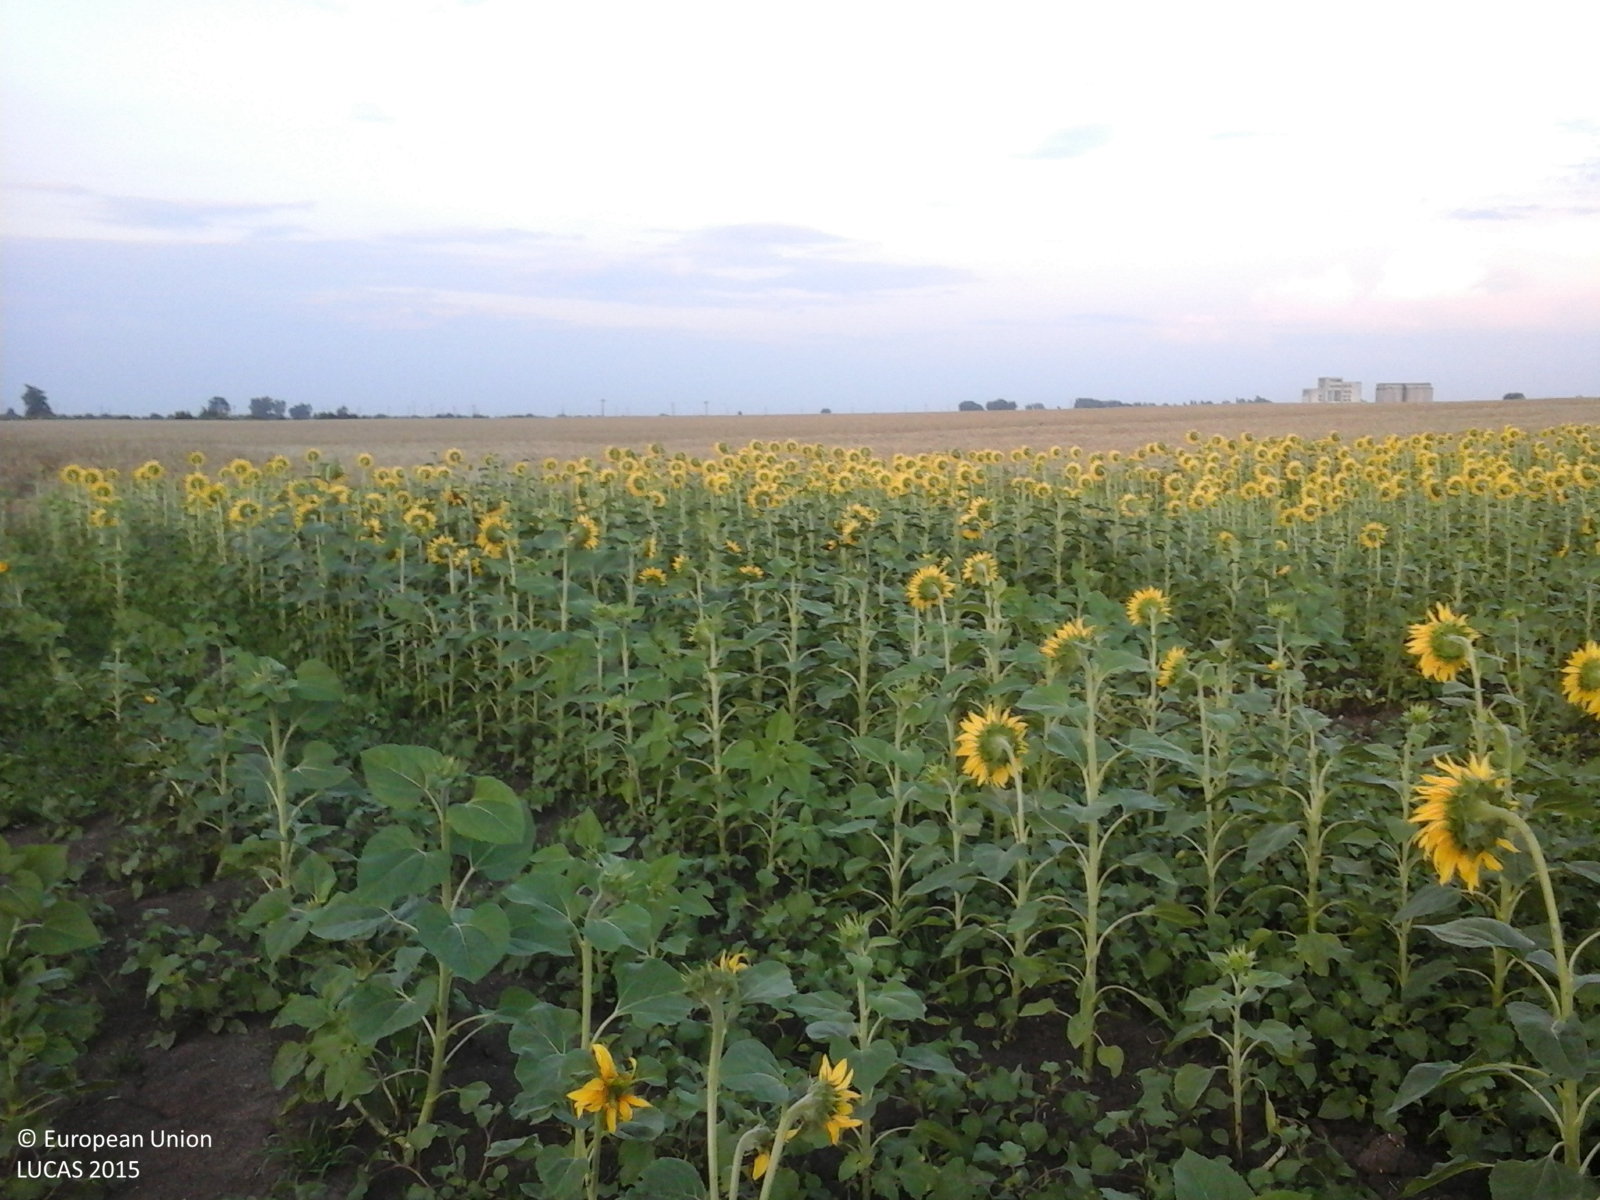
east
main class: Cropland
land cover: Sunflower
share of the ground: > 75 %
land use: Agriculture (excluding fallow land and kitchen gardens)
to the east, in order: Sunflower; Common wheat
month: July
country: RO
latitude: 43.9327
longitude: 25.9539
